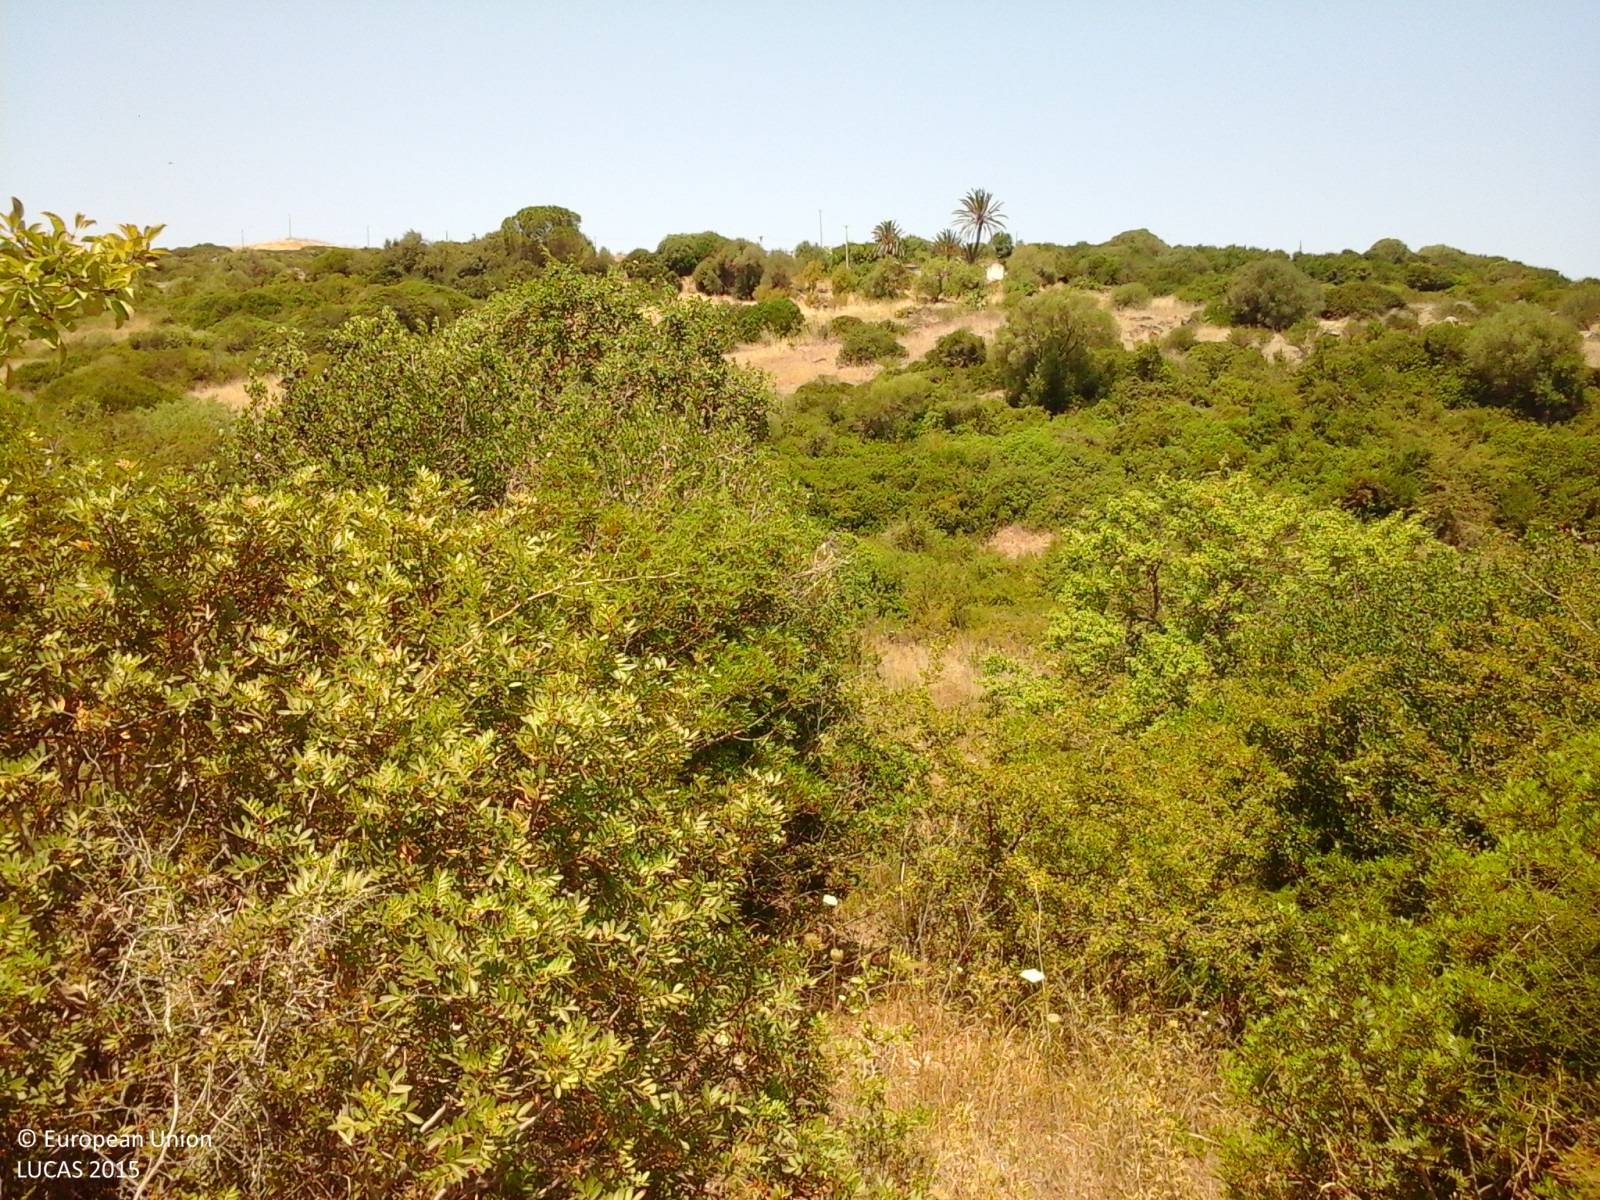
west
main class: Shrubland
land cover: Shrubland with sparse tree cover
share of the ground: > 75 %
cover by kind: herbaceous plants 55 %, shrubs 40 %, broadleaved forest trees 5 %
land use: Semi-natural and natural areas not in use
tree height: < 5 m
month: July
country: IT
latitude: 40.8401
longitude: 8.8786
